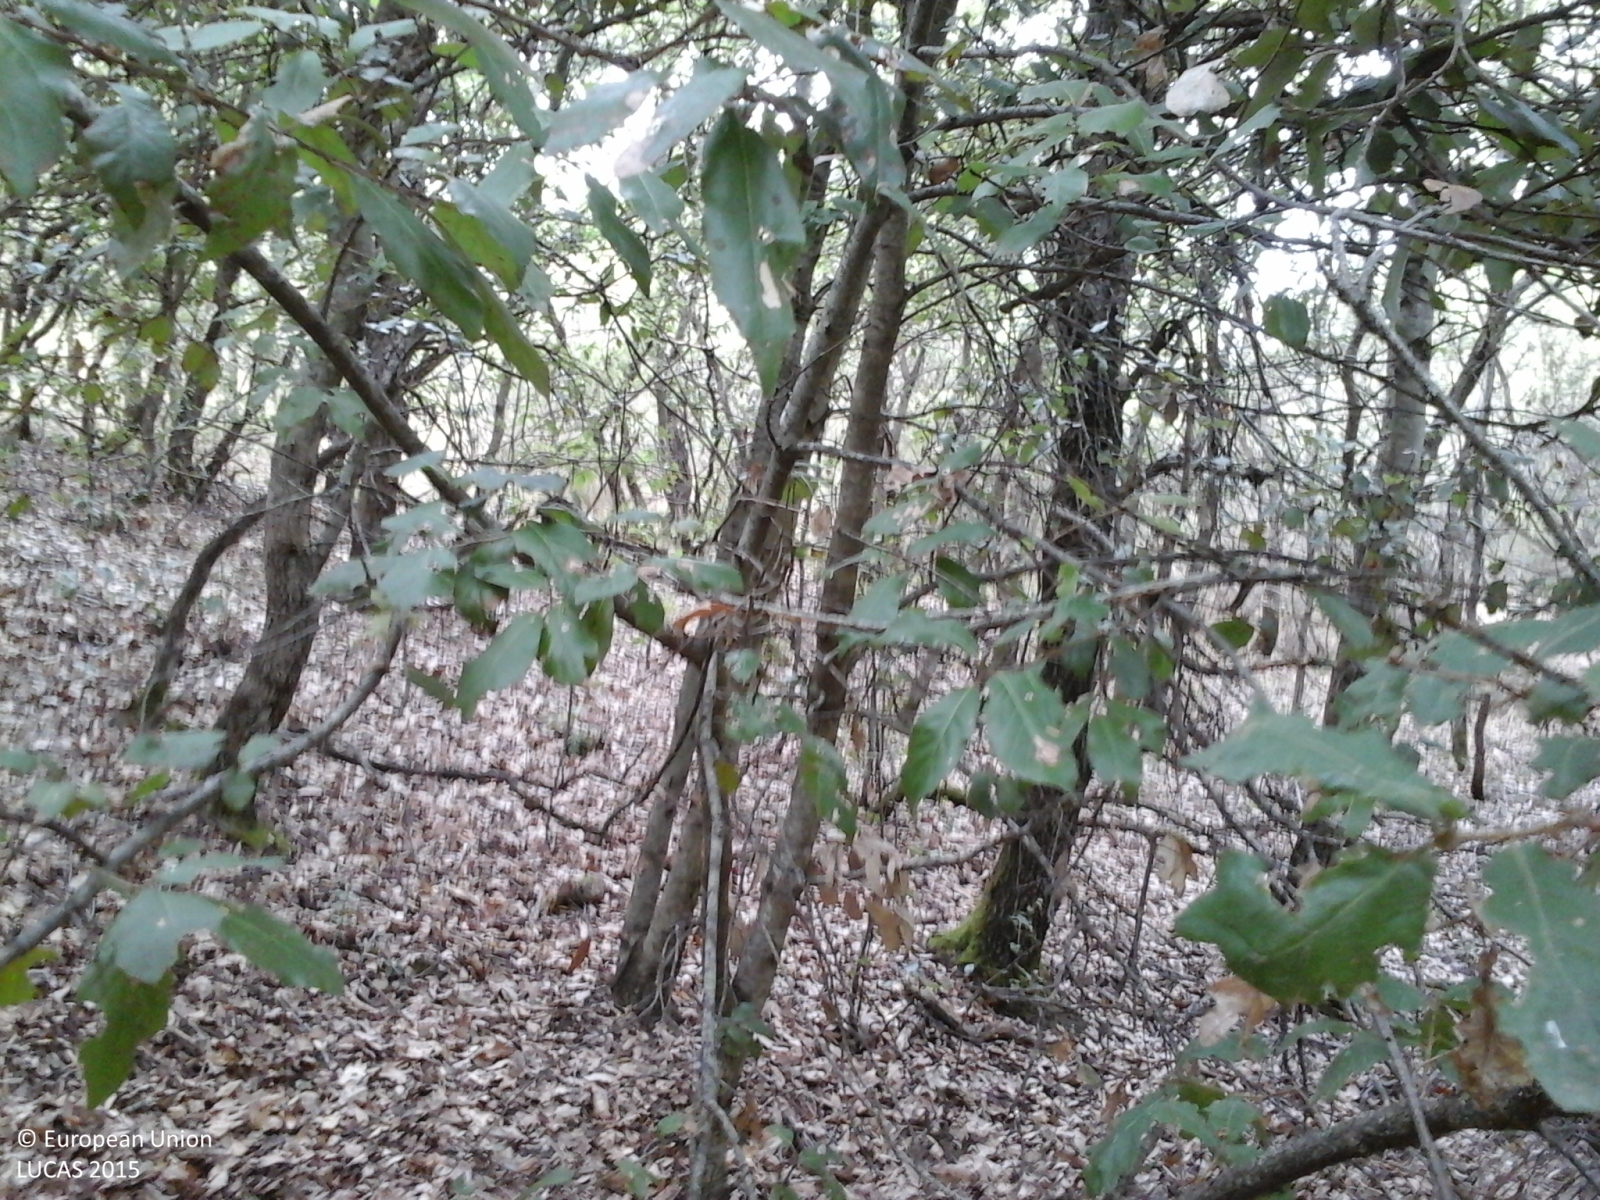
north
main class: Woodland
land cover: Broadleaved woodland
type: thermophilous deciduous forest
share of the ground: > 75 %
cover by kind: broadleaved forest trees 75 %, shrubs 20 %, herbaceous plants 5 %
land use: Forestry
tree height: > 5 m
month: July
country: IT
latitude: 43.0221
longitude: 11.5047
